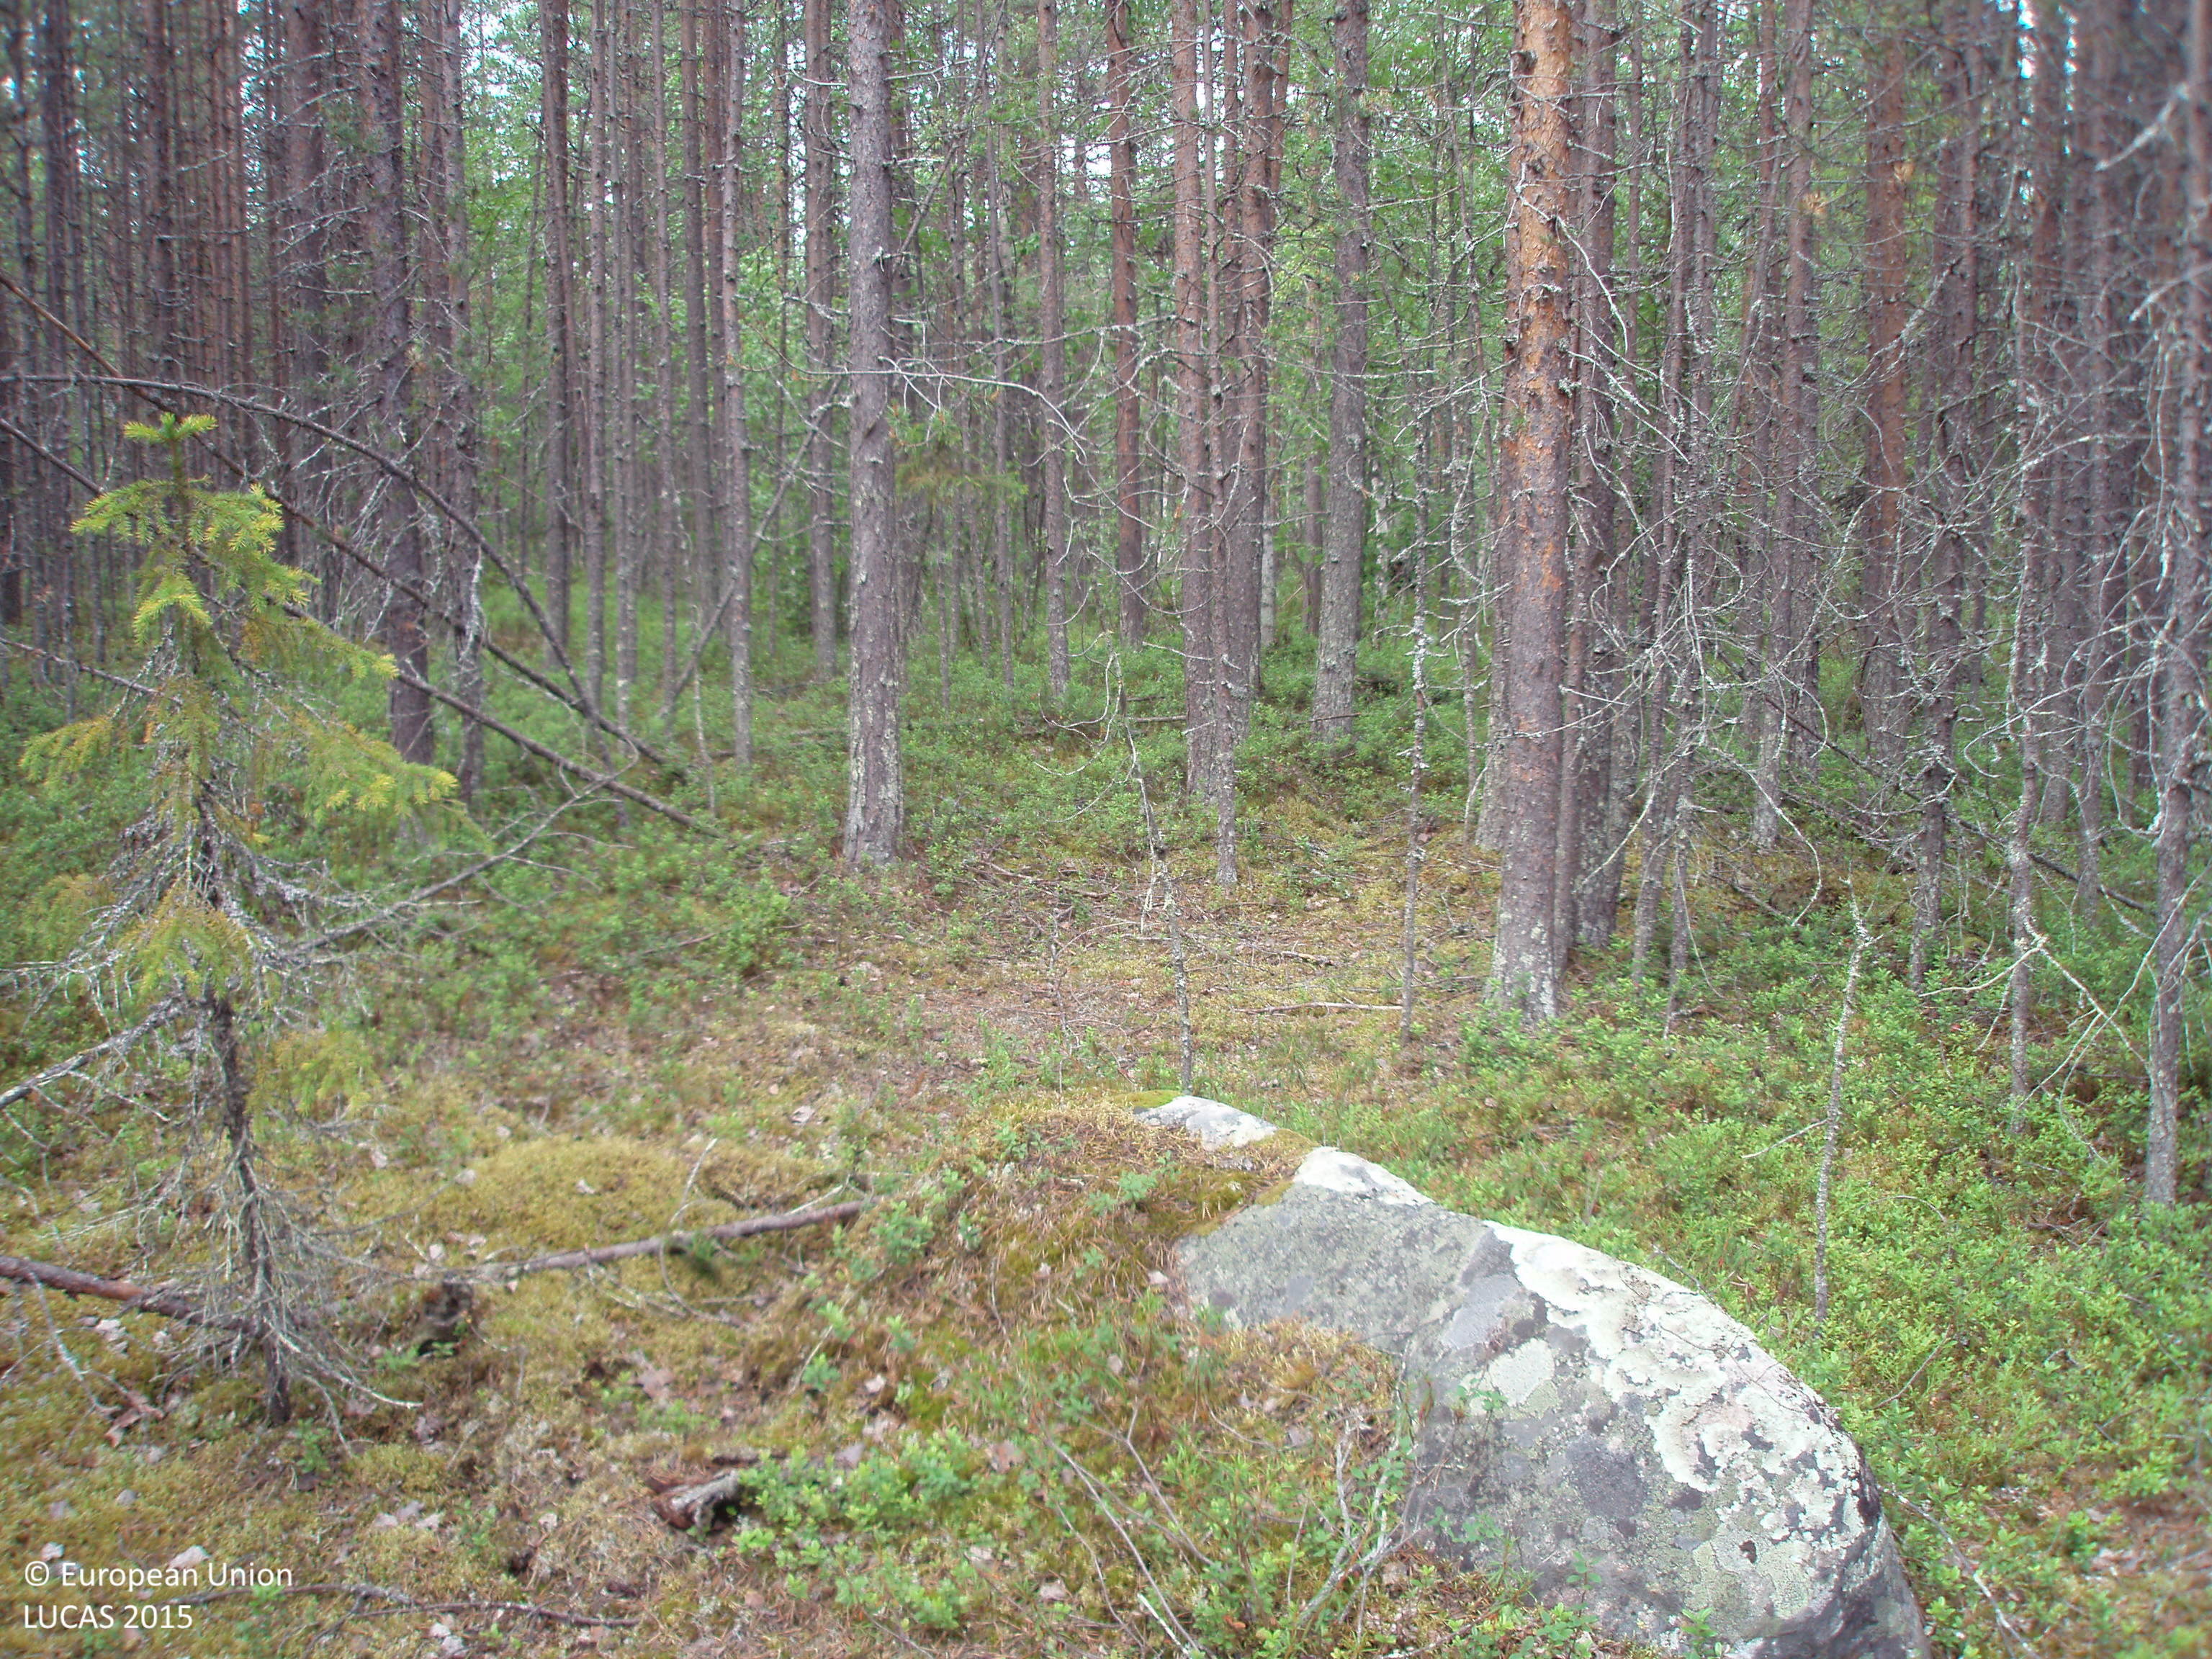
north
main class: Woodland
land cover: Pine dominated coniferous woodland
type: boreal forest
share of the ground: > 75 %
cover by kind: coniferous forest trees 70 %, shrubs 20 %, broadleaved forest trees 5 %, lichens and mosses 5 %
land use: Forestry
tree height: > 5 m
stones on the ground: 10 - 25 %
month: July
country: FI
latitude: 66.8945
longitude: 28.4282
